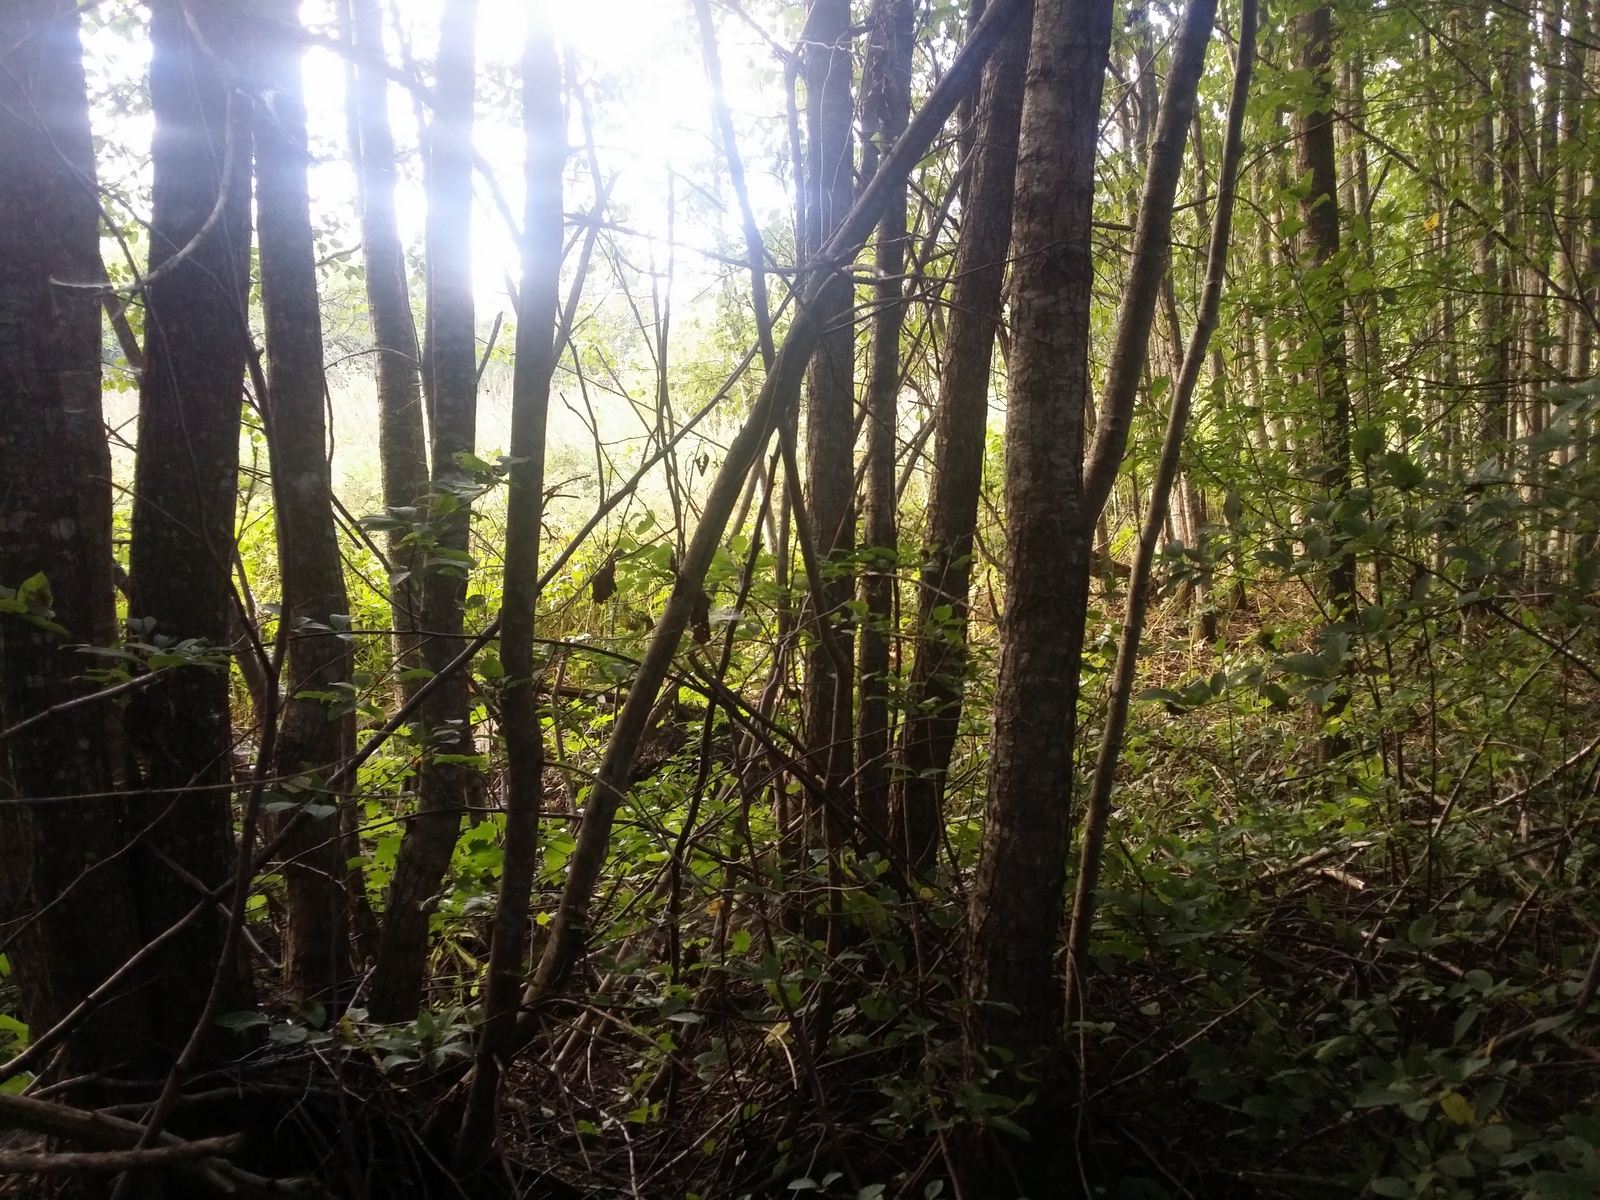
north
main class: Woodland
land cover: Broadleaved woodland
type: non-riverine alder, birch or aspen forest
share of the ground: > 75 %
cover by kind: broadleaved forest trees 85 %, herbaceous plants 10 %, unconsolidated bare surface 5 %
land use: Forestry
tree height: > 5 m
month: August
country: LV
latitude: 57.2337
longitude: 27.6930
